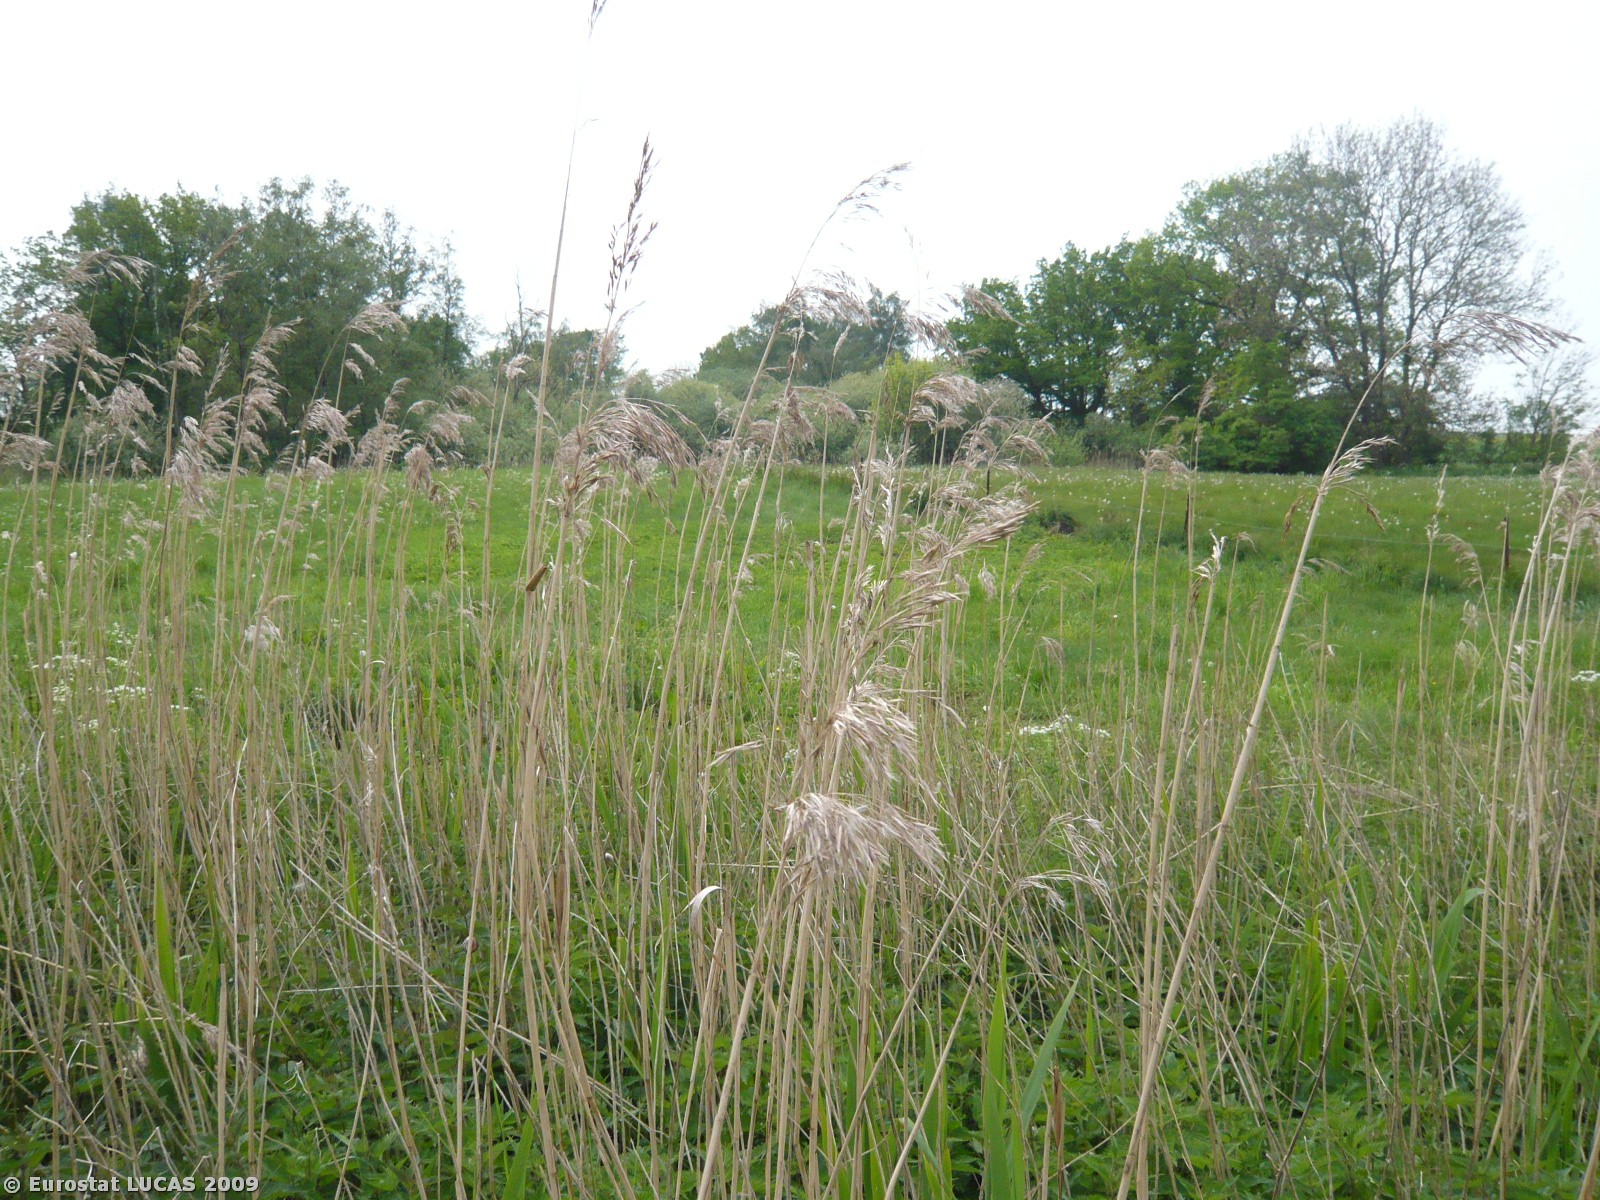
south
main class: Wetlands
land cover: Inland marshes
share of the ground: > 75 %
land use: Unused
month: May
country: DK
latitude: 55.2217
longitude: 11.8378
